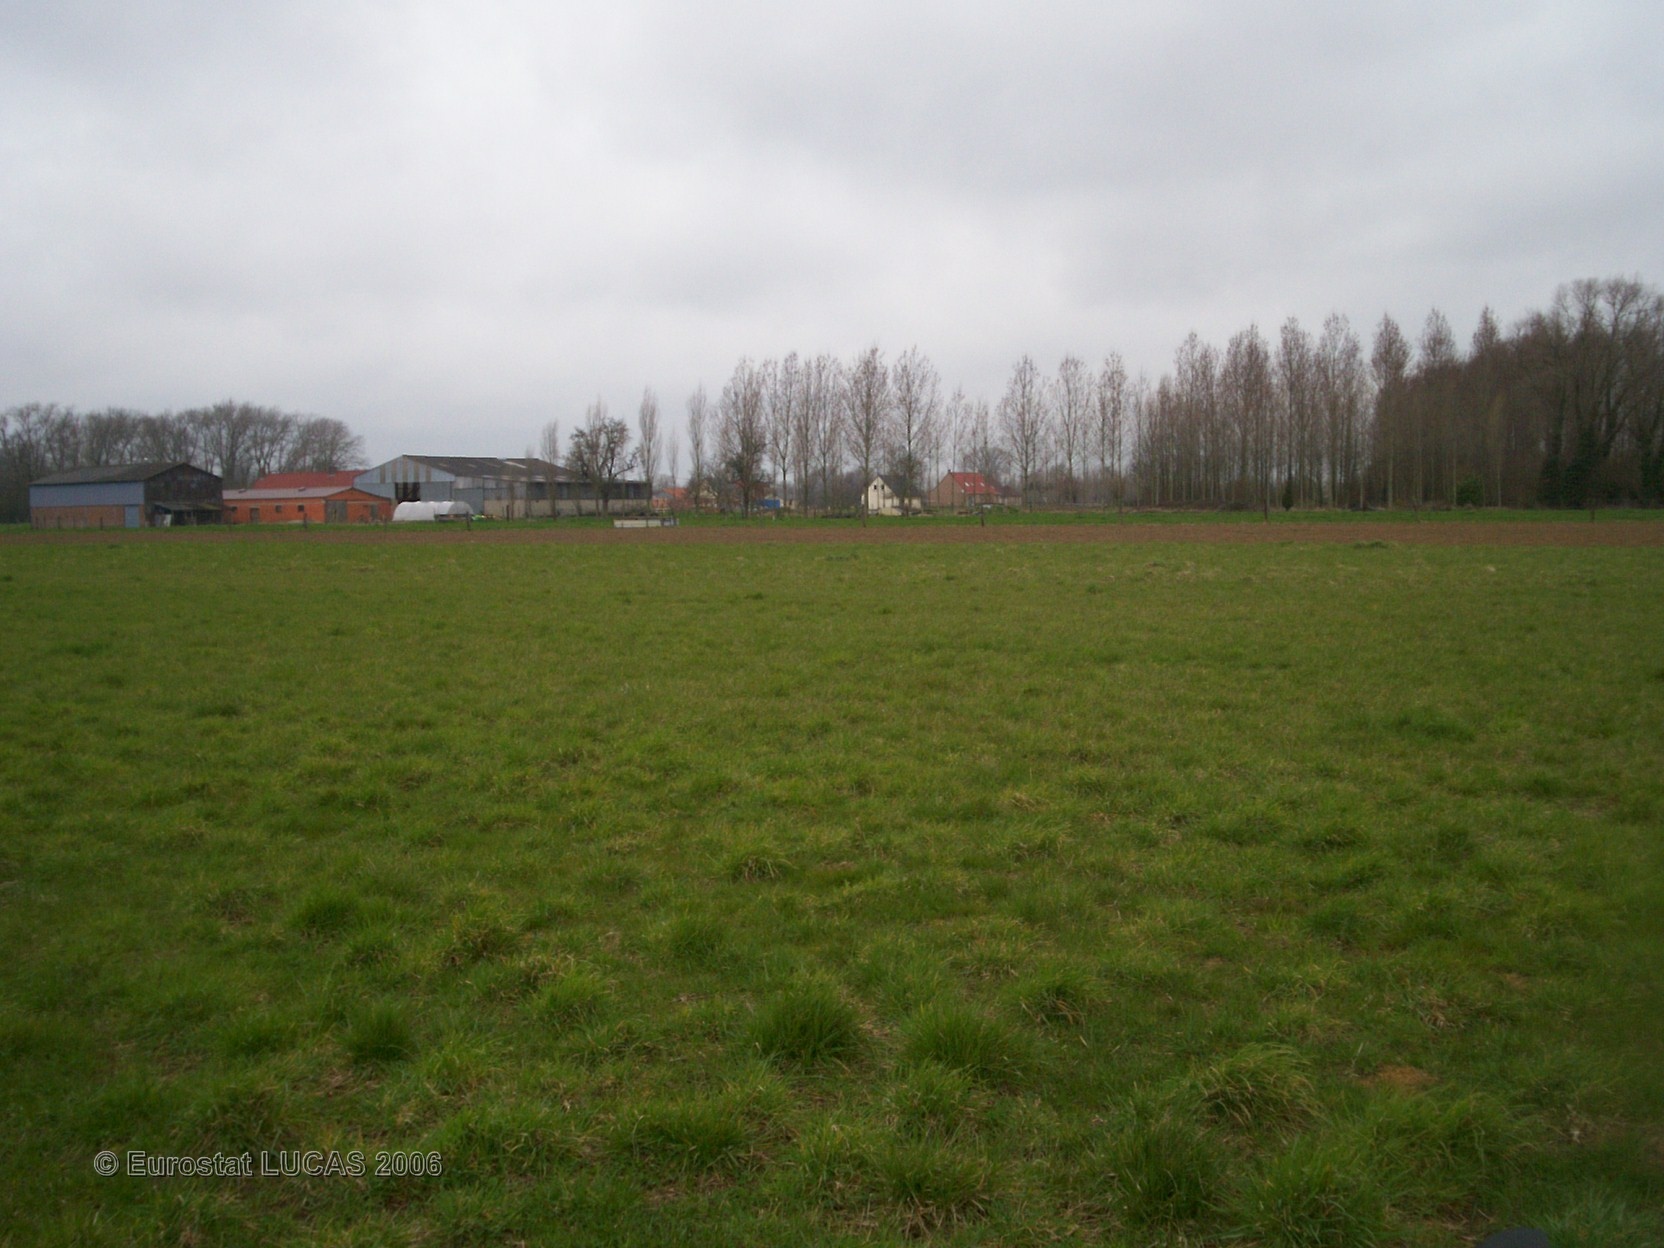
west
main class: Grassland
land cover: Grassland without tree/shrub cover
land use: Agriculture (excluding fallow land and kitchen gardens)
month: April
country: FR
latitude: 50.5864
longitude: 2.4873
